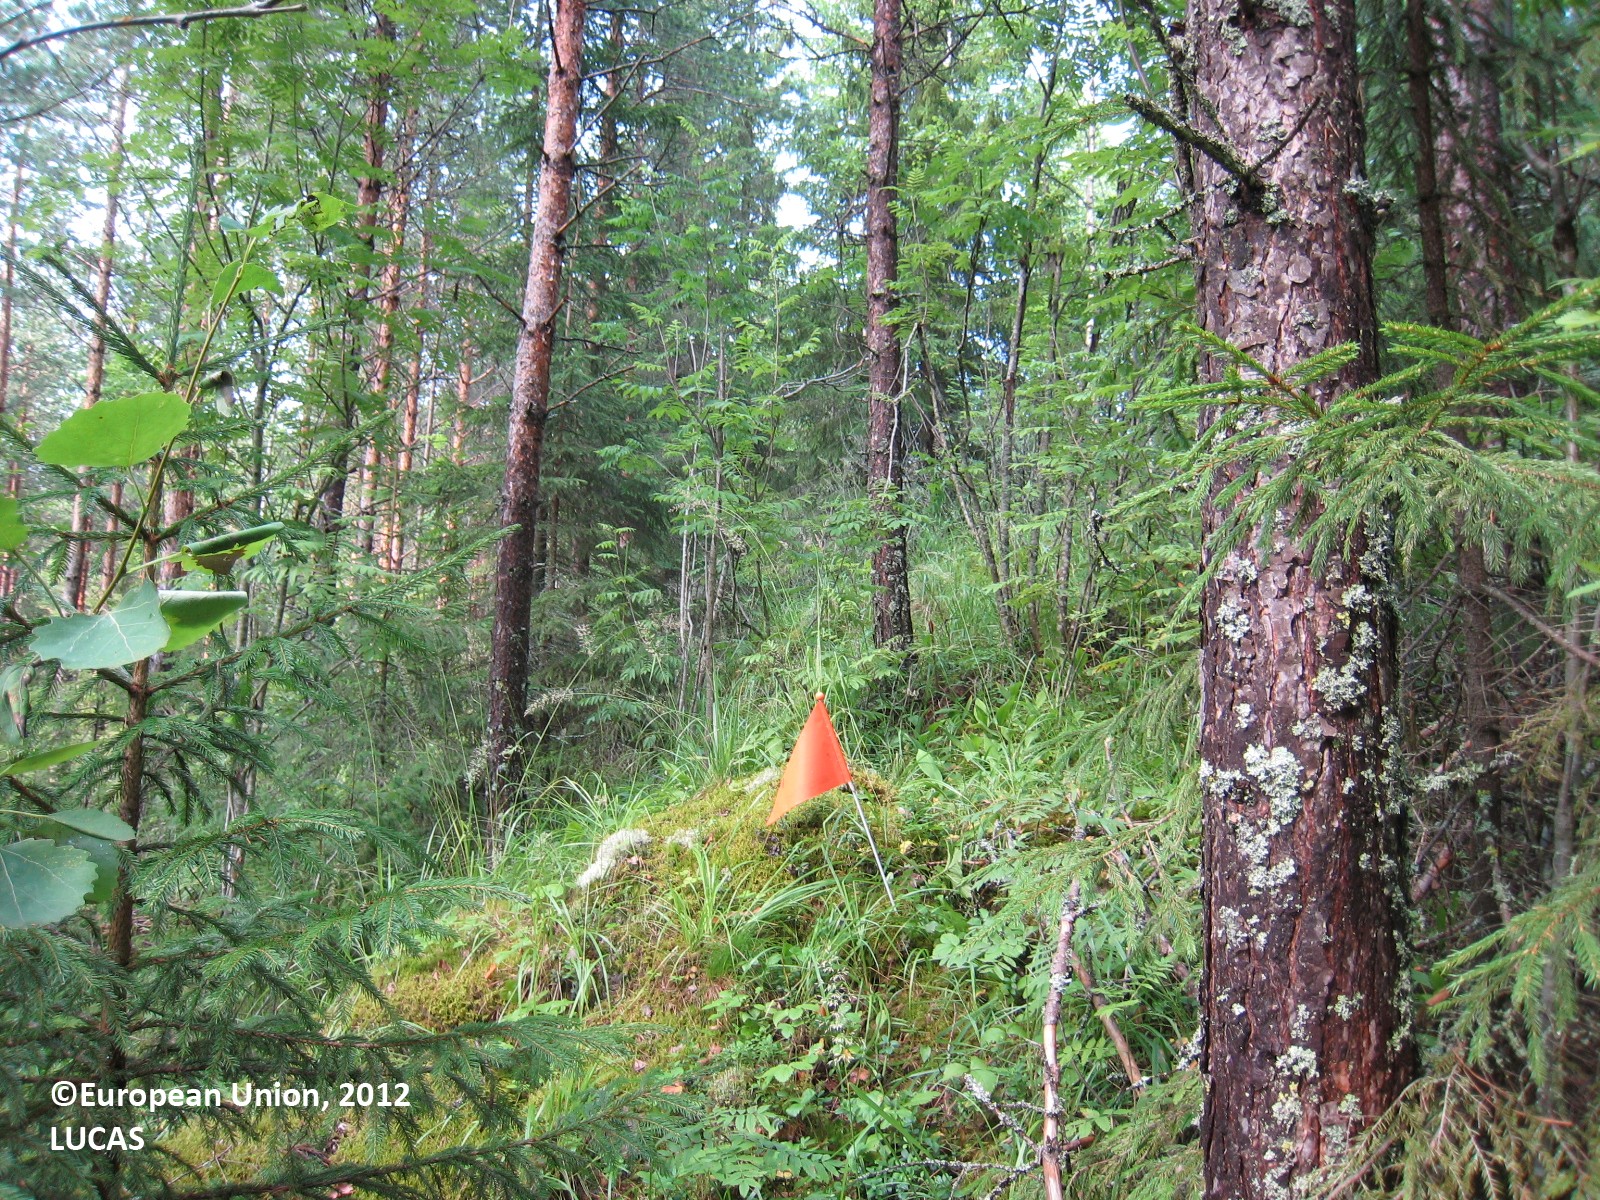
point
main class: Woodland
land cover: Other coniferous woodland
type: boreal forest
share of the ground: > 75 %
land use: Forestry
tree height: > 5 m
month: July
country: FI
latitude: 62.4588
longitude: 27.3985
